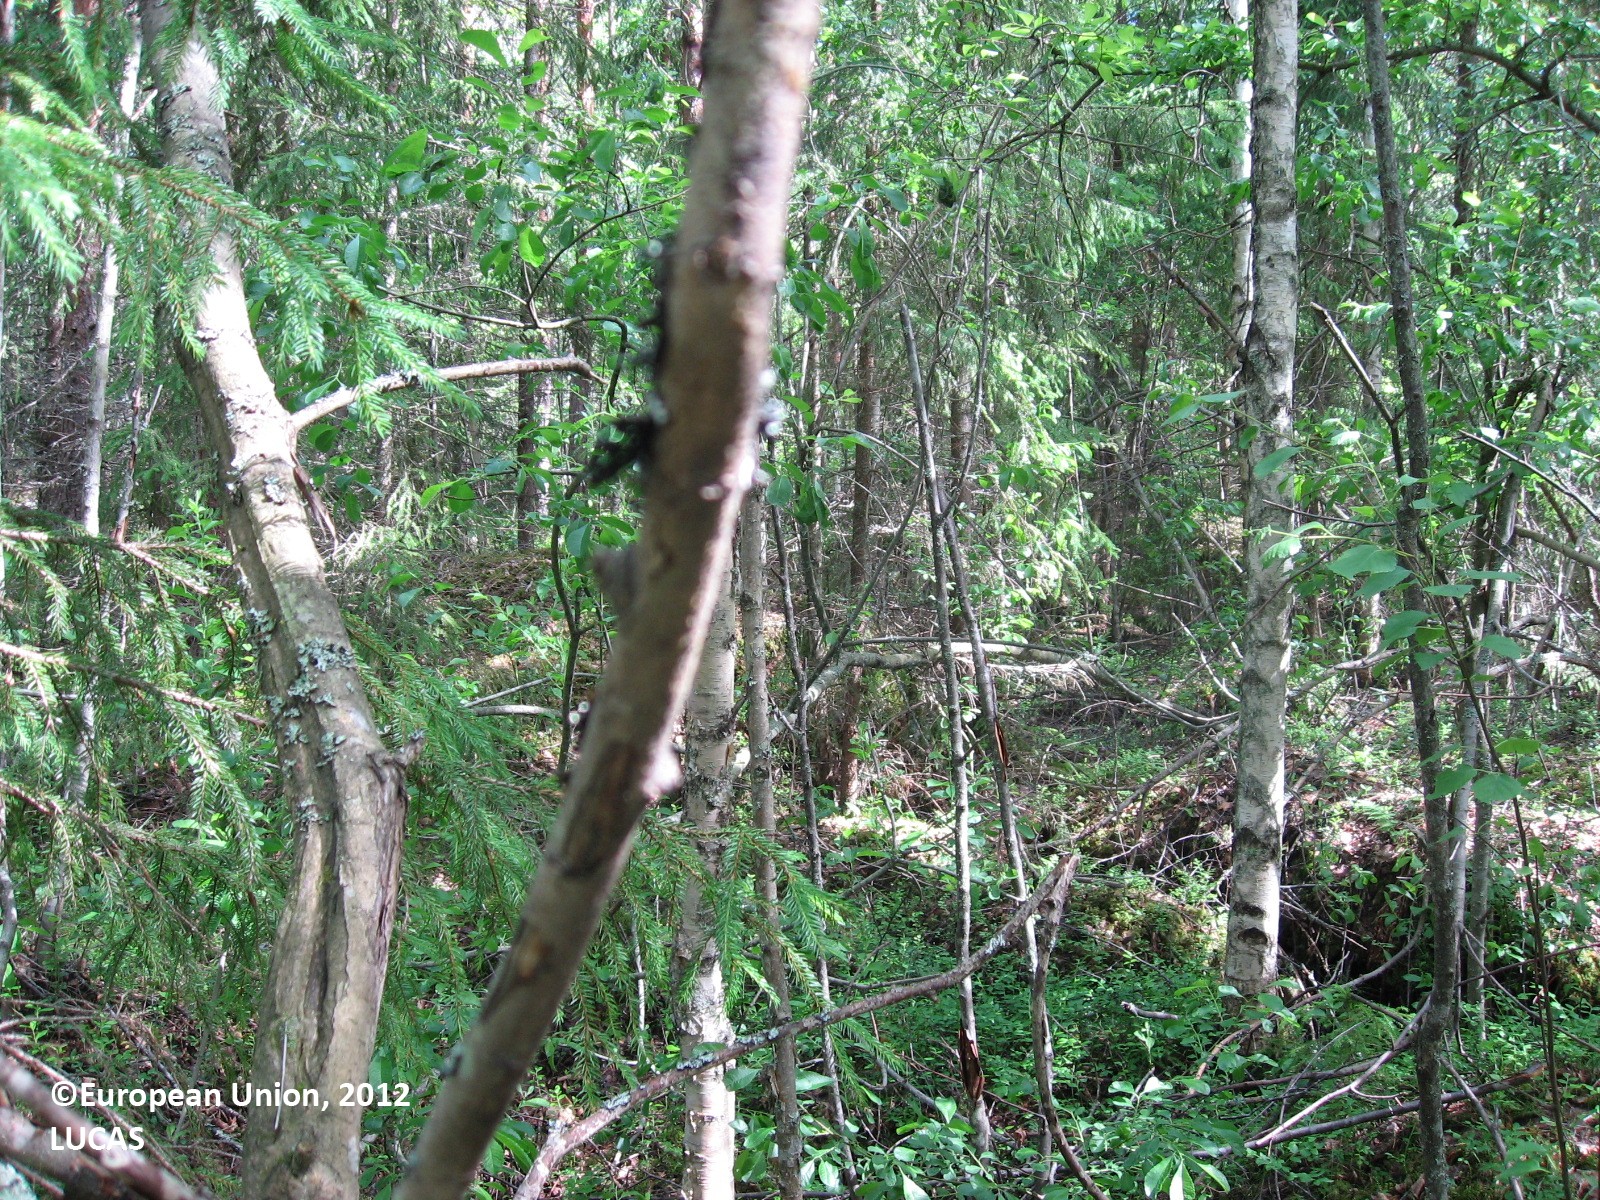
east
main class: Woodland
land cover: Spruce dominated mixed woodland
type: boreal forest
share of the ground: > 75 %
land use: Forestry
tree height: > 5 m
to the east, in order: Spruce dominated mixed woodland; Lichens and moss; Spruce dominated mixed woodland; Ditches and canals; Spruce dominated mixed woodland; Ditches and canals; Spruce dominated mixed woodland; Rivers and streams; Spruce dominated mixed woodland
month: June
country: FI
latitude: 60.5522
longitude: 26.2875
